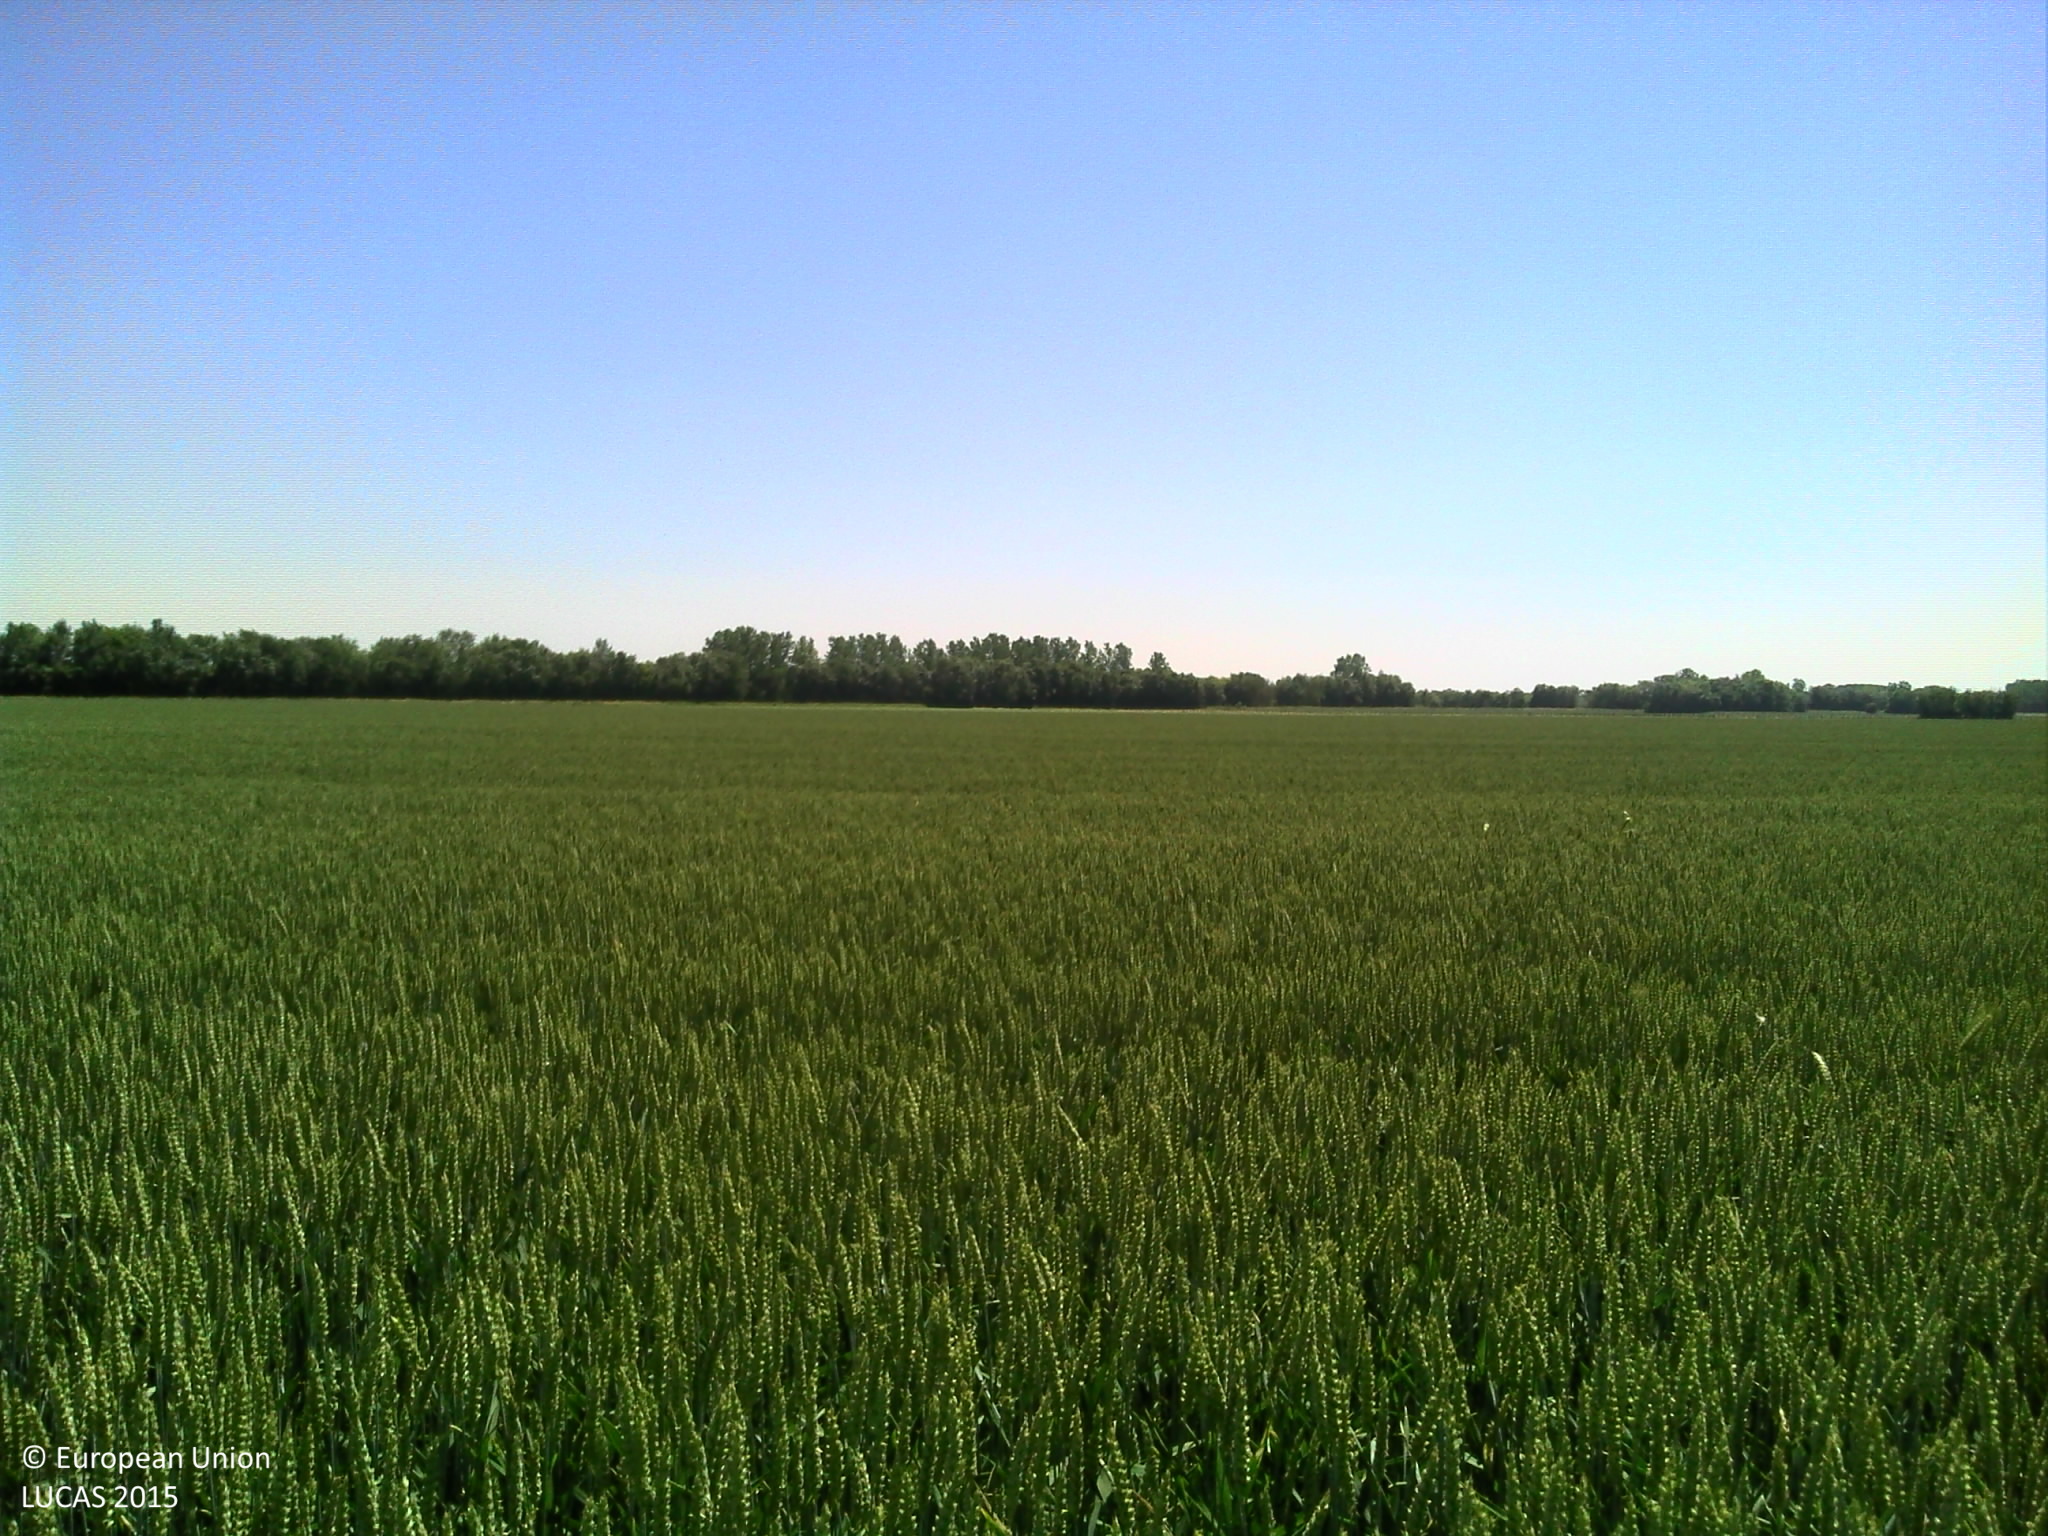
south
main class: Cropland
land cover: Common wheat
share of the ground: > 75 %
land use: Agriculture (excluding fallow land and kitchen gardens)
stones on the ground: < 10 %
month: June
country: FR
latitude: 46.4647
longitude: 4.9105
